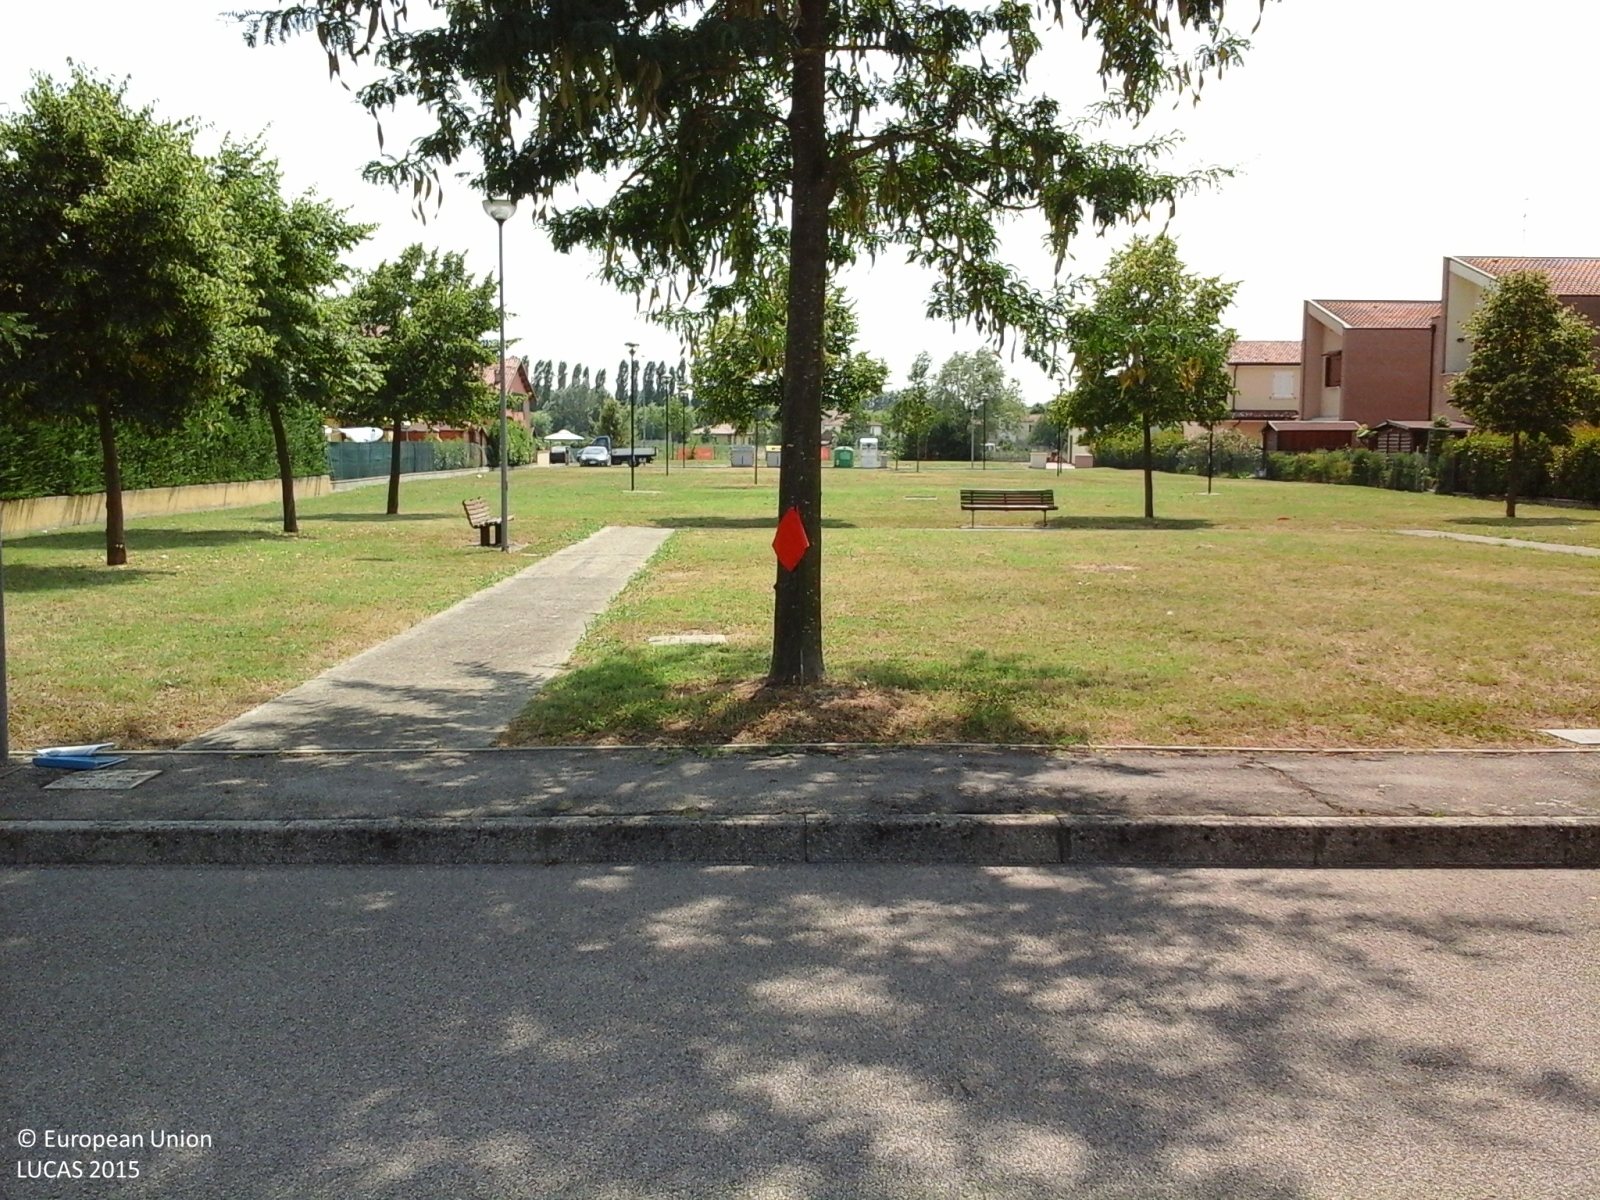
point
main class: Grassland
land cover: Grassland with sparse tree/shrub cover
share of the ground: > 75 %
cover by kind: herbaceous plants 95 %, broadleaved forest trees 5 %
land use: Residential
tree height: > 5 m
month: July
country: IT
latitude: 44.6621
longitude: 11.6488
